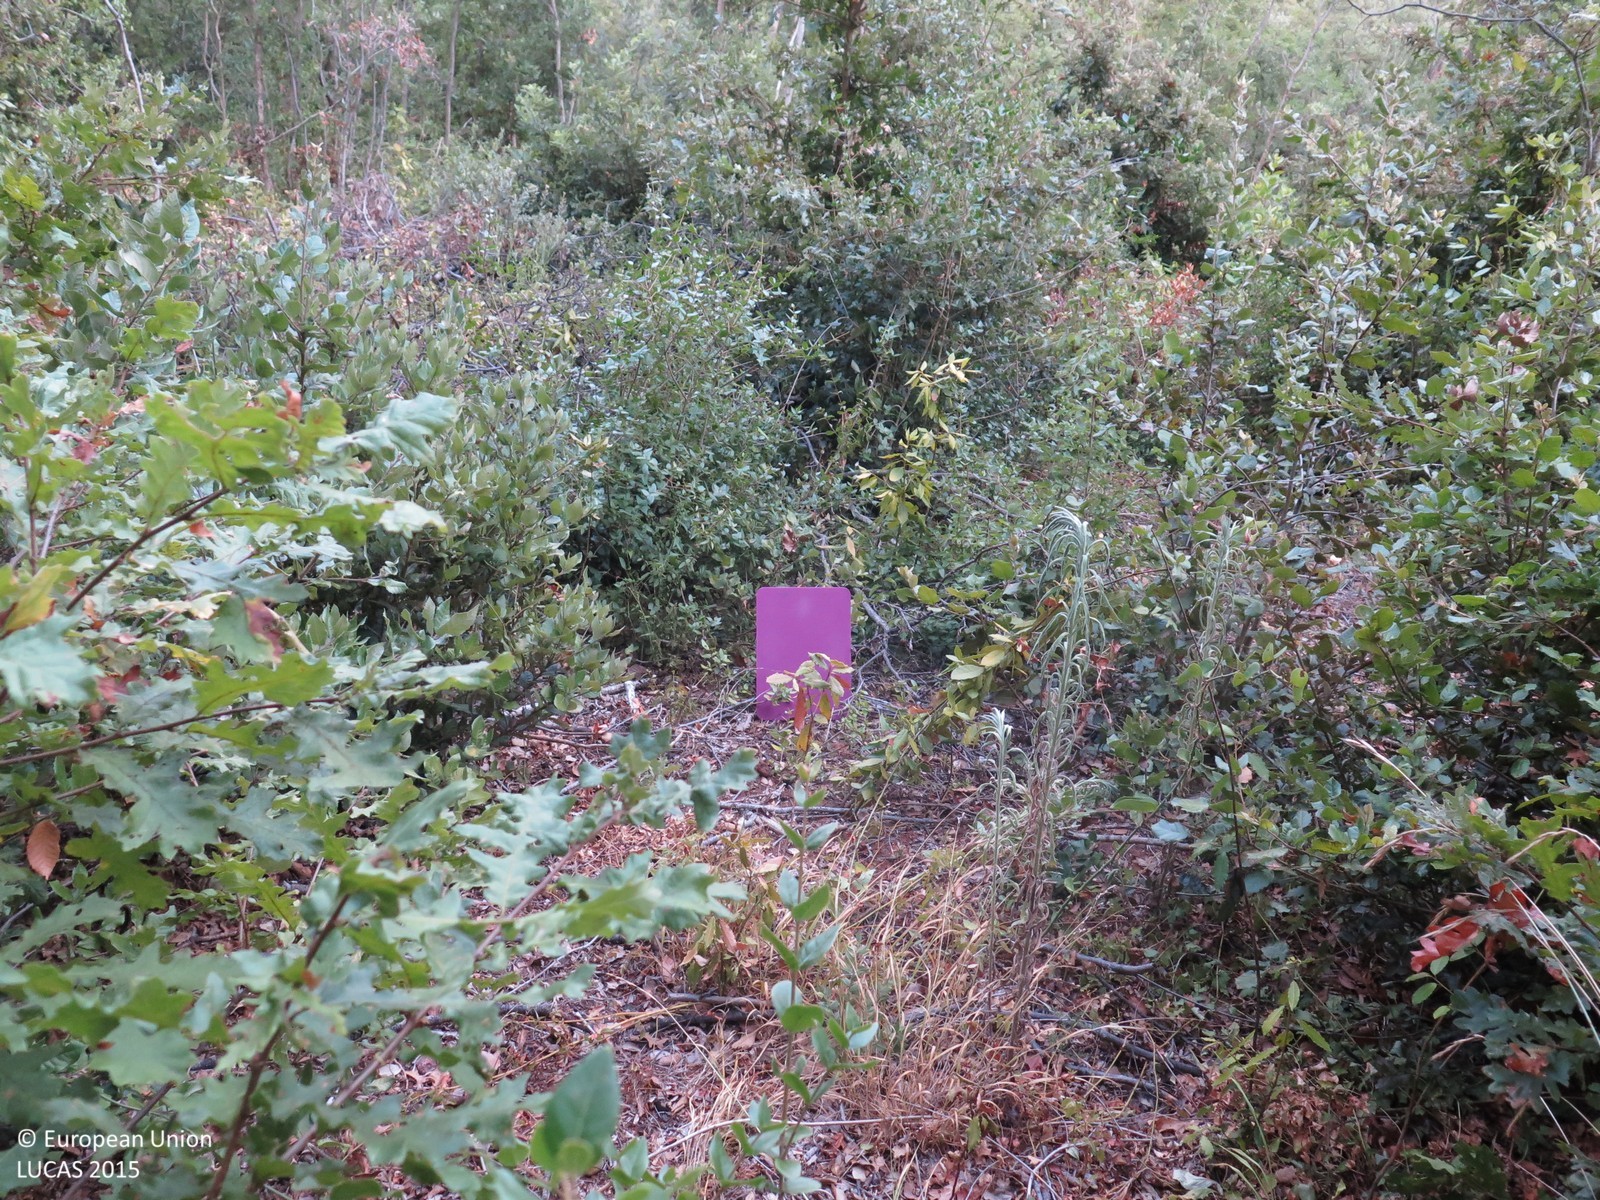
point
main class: Shrubland
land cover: Shrubland with sparse tree cover
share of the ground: > 75 %
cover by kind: shrubs 85 %, broadleaved forest trees 5 %, herbaceous plants 5 %, unconsolidated bare surface 5 %
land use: Semi-natural and natural areas not in use
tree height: > 5 m
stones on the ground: 10 - 25 %
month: August
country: HR
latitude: 44.9220
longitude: 14.0354
